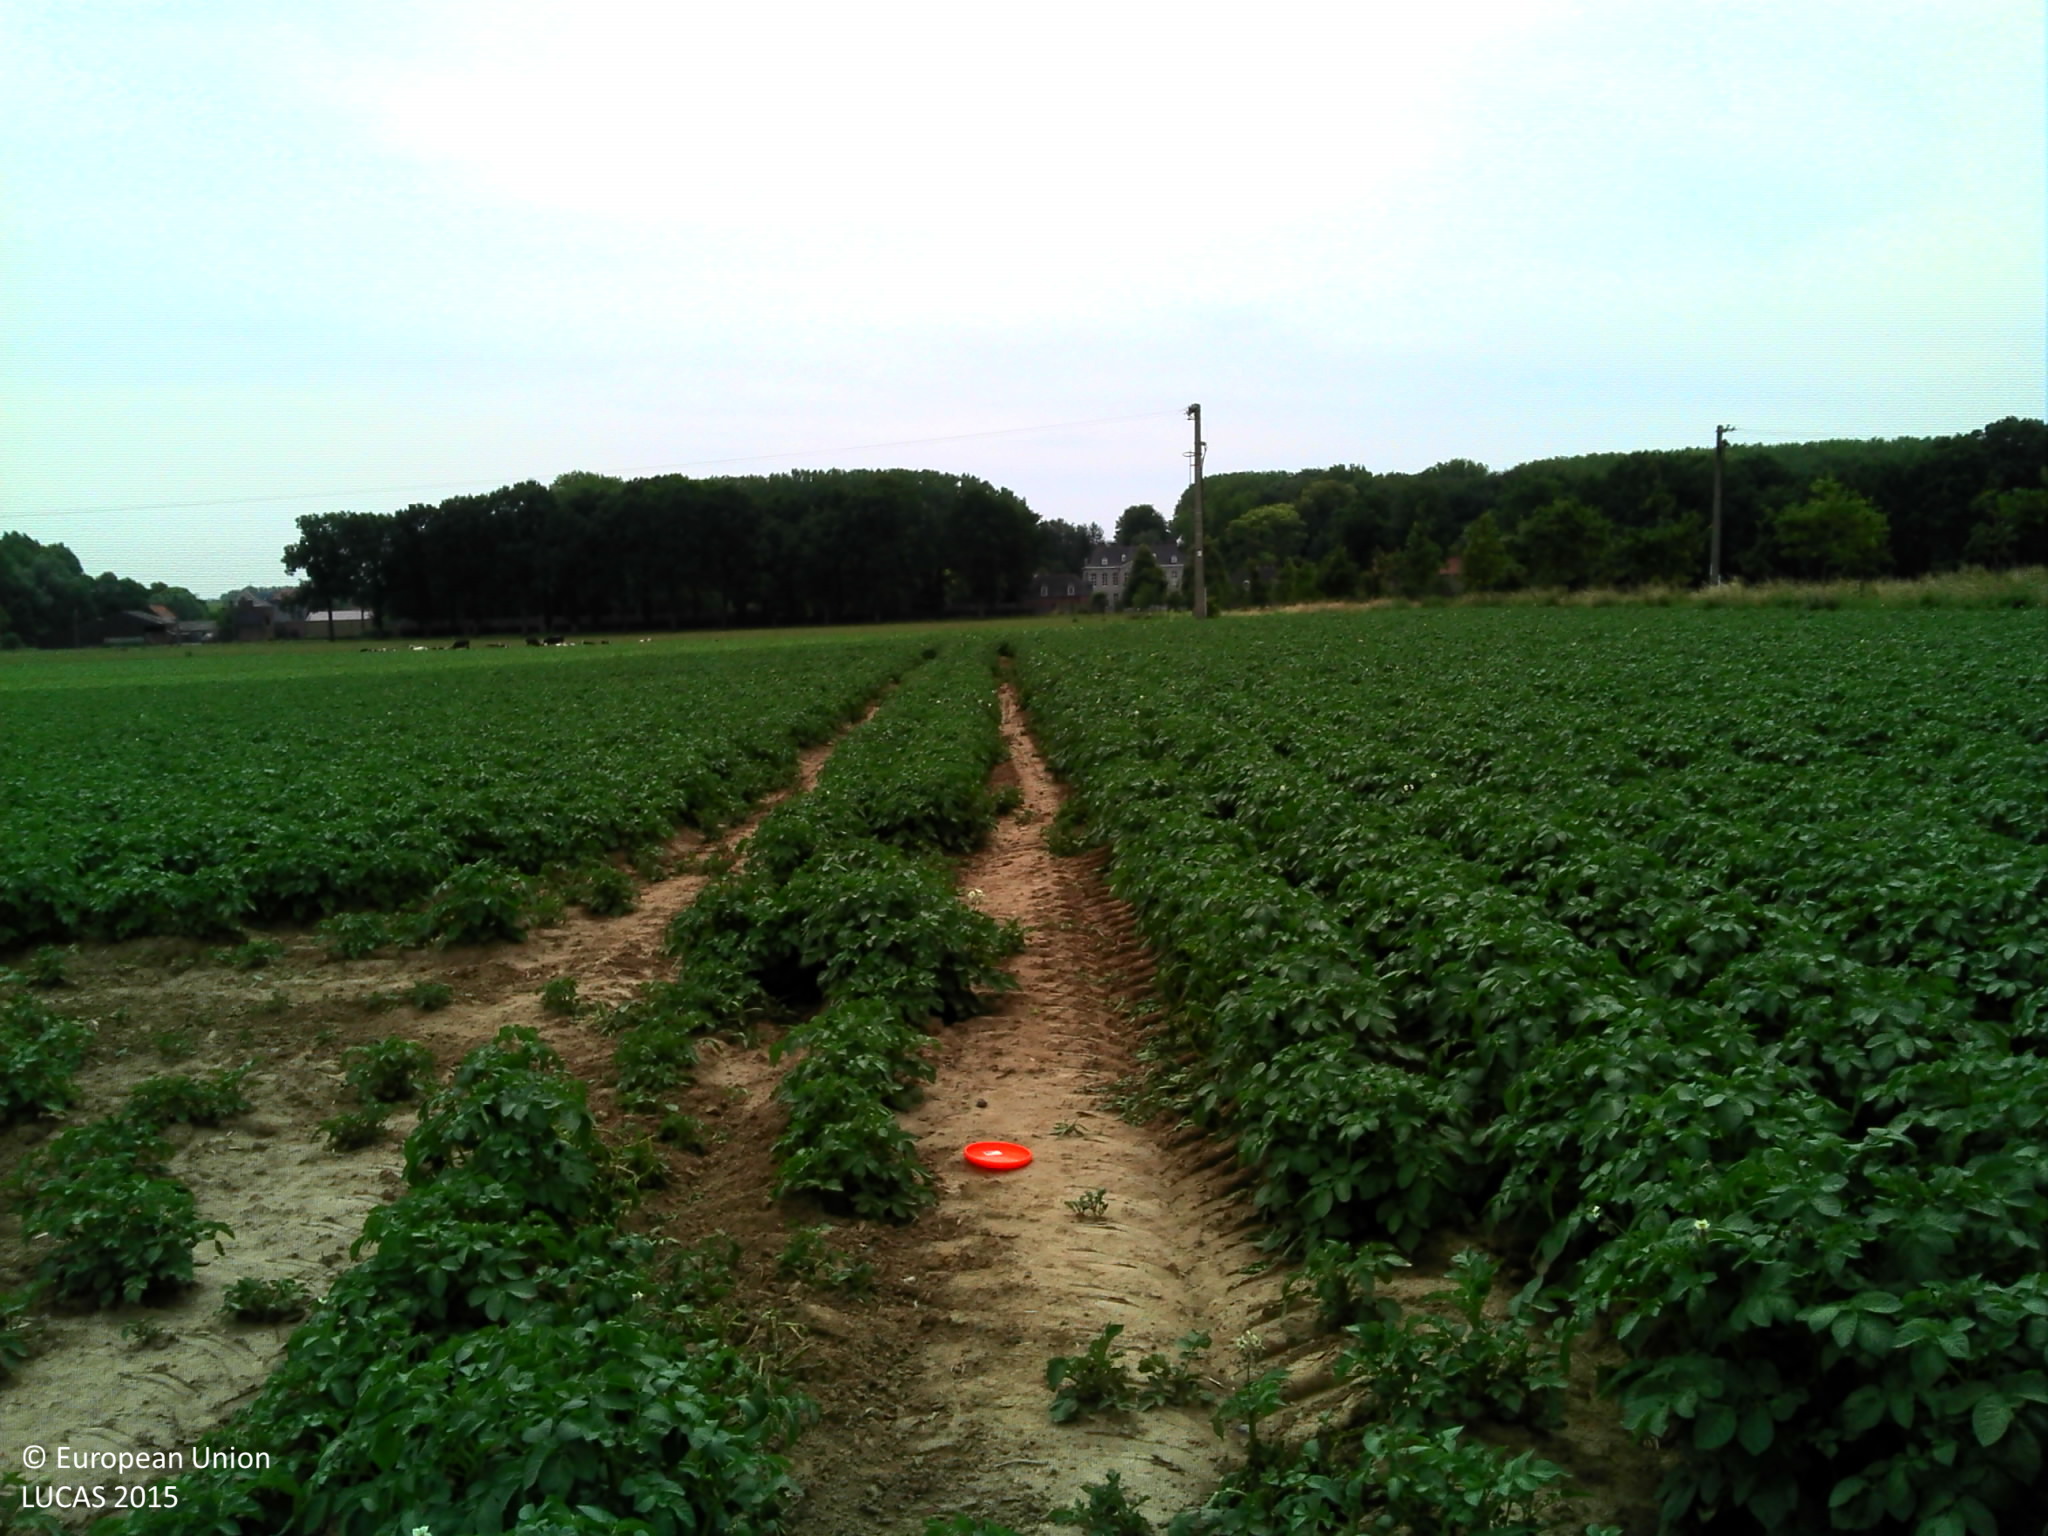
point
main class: Cropland
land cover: Potatoes
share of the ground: > 75 %
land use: Agriculture (excluding fallow land and kitchen gardens)
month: June
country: BE
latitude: 50.6040
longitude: 3.6771
